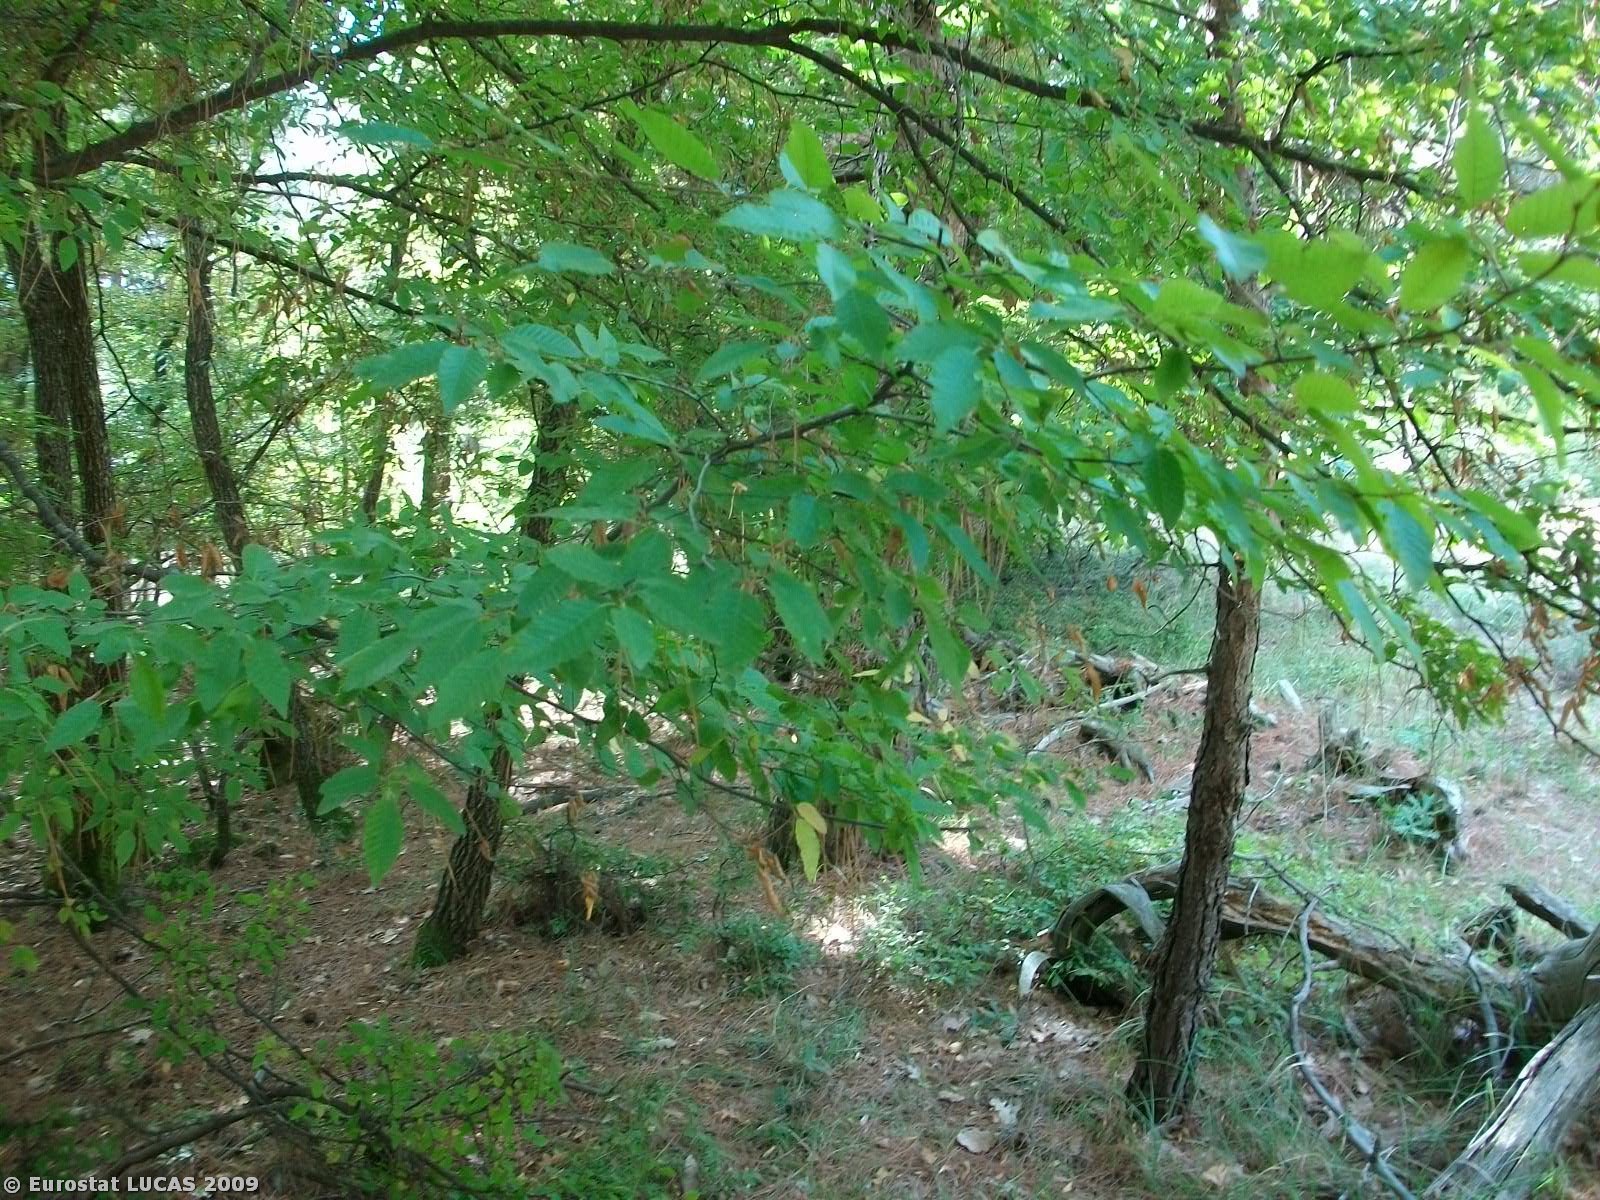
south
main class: Woodland
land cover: Mixed woodland
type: coniferous forest of the mediterranean region
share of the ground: > 75 %
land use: Nature reserves
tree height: > 5 m
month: October
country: GR
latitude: 41.1106
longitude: 26.2512
